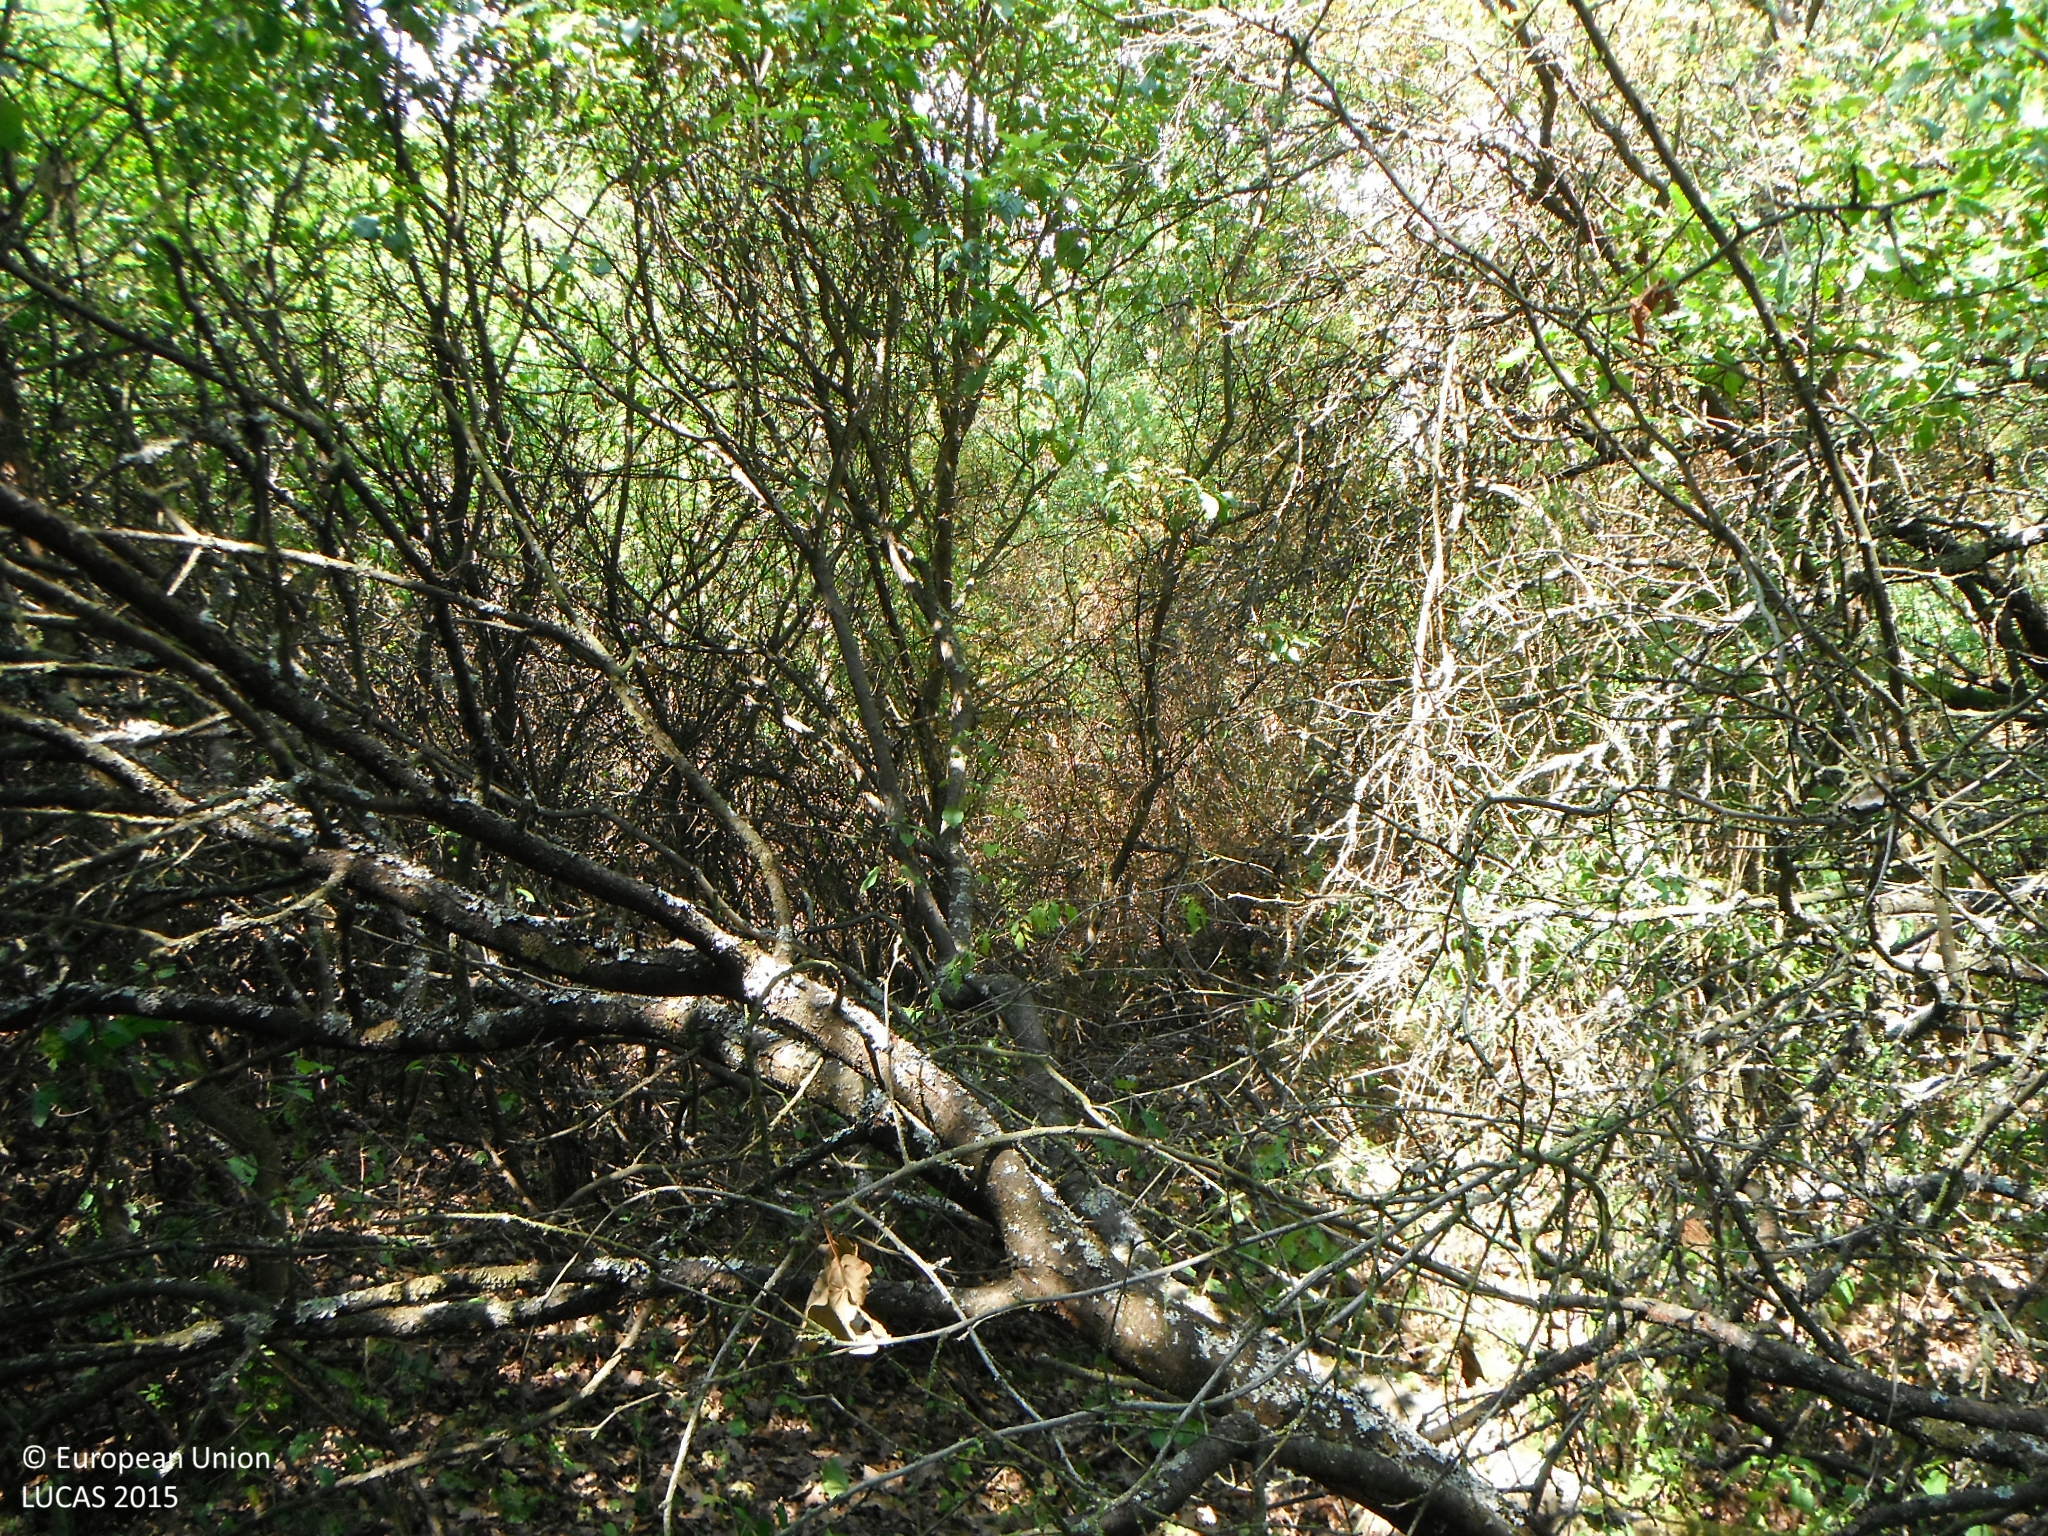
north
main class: Woodland
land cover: Broadleaved woodland
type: thermophilous deciduous forest
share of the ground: > 75 %
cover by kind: broadleaved forest trees 90 %, shrubs 10 %
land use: Forestry
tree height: > 5 m
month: July
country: SK
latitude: 48.2193
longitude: 18.9703
